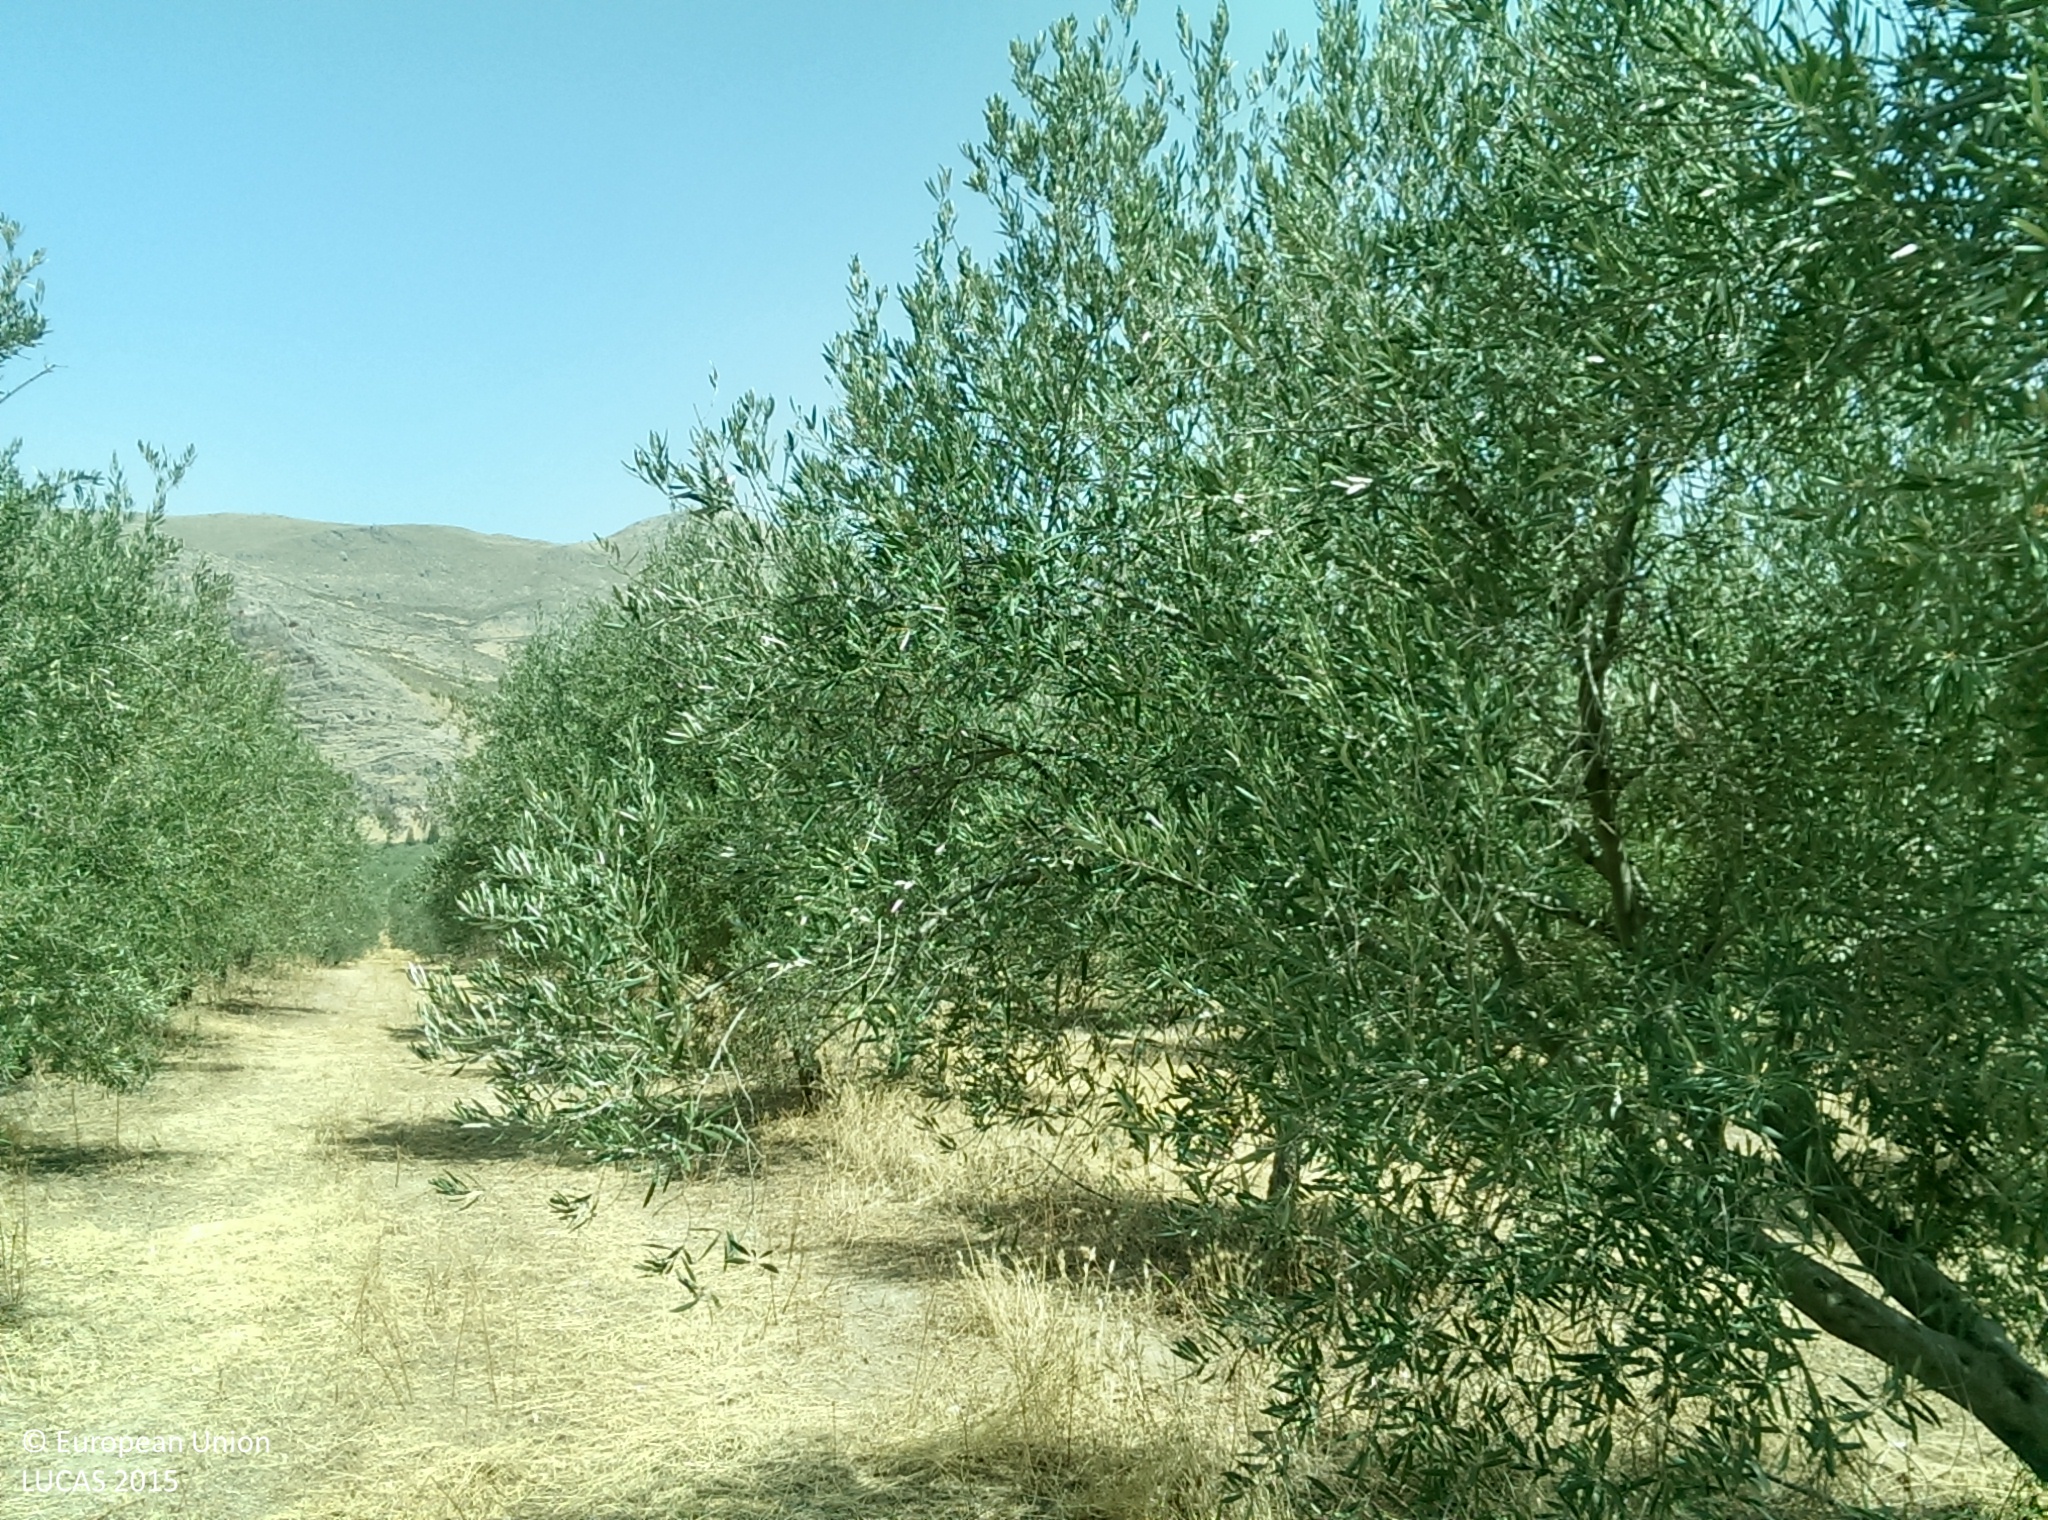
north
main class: Cropland
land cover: Olive groves
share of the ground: 25 - 50 %
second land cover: Spontaneously vegetated surfaces
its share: > 75 %
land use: Agriculture (excluding fallow land and kitchen gardens)
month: July
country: ES
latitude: 37.2273
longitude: -3.7075
